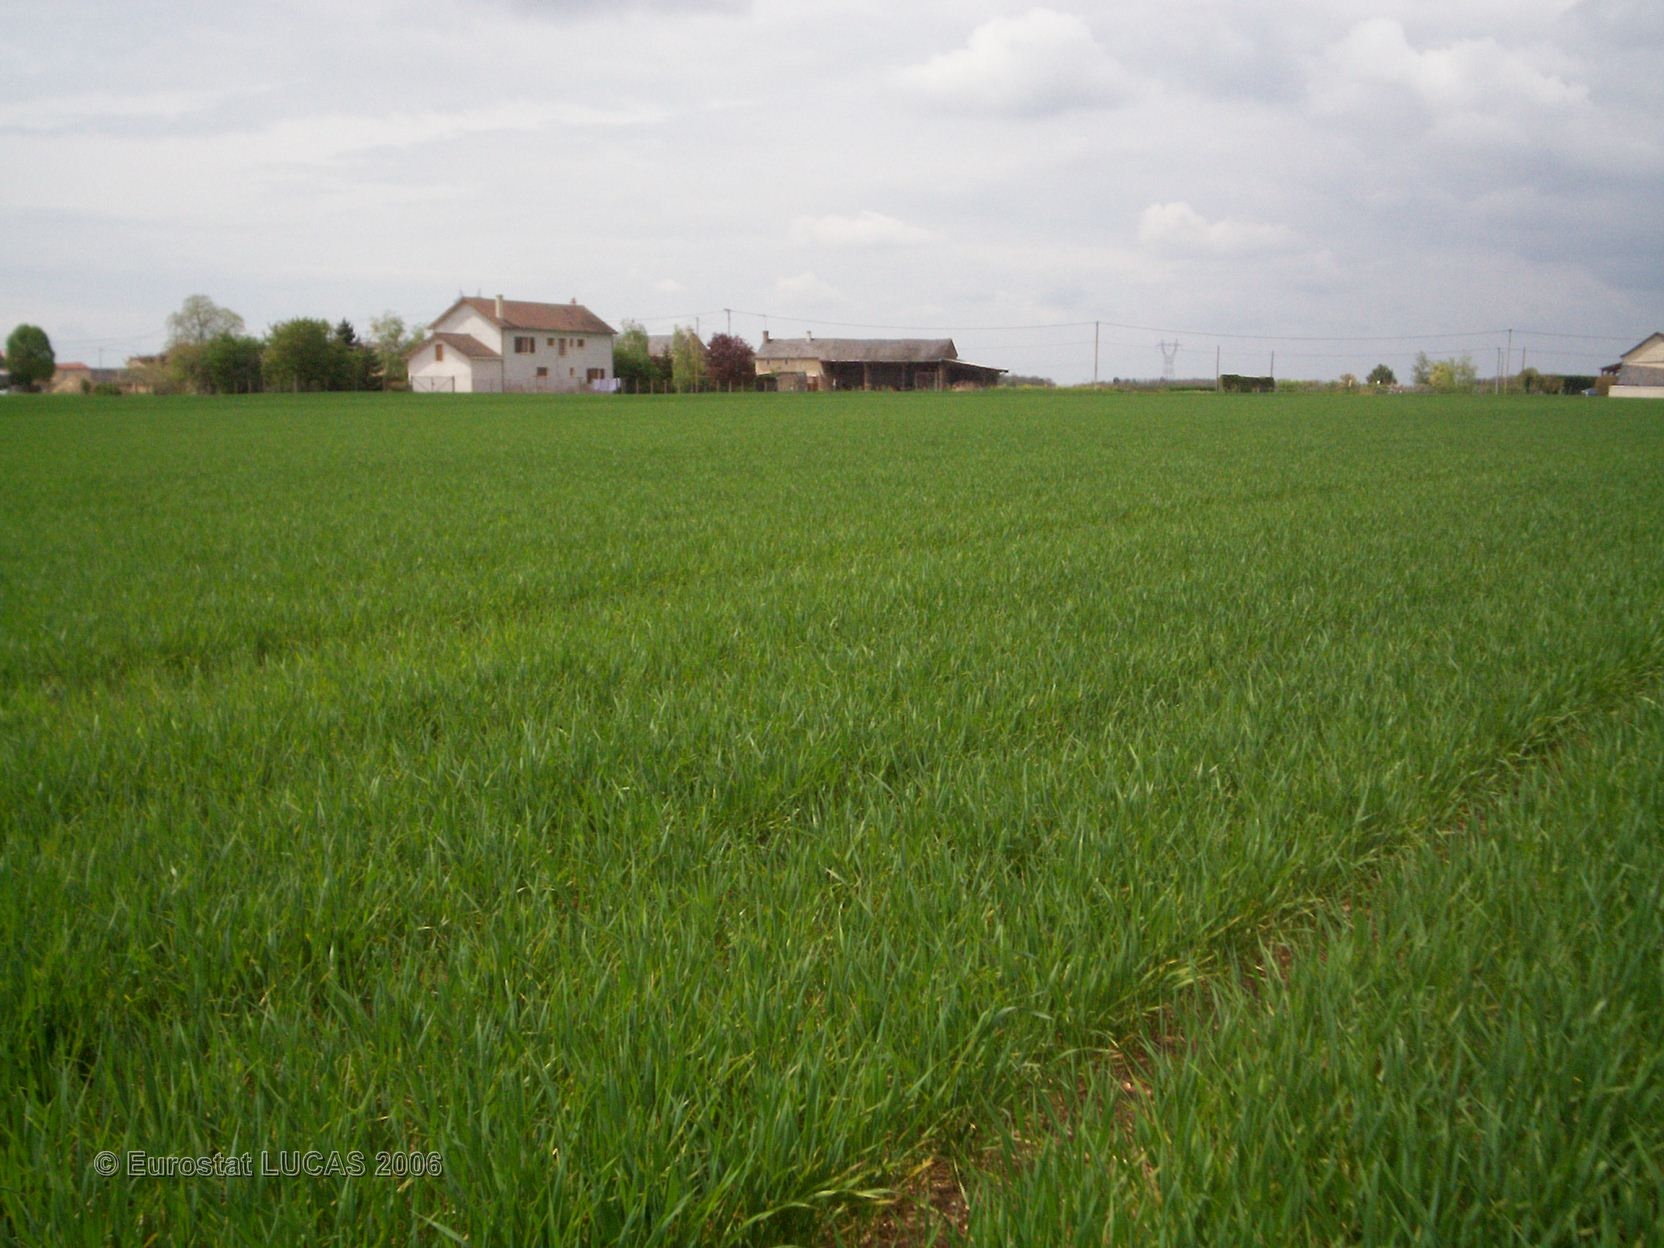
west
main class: Cropland
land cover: Barley
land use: Agriculture (excluding fallow land and kitchen gardens)
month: April
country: FR
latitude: 47.0449
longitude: 0.2248
